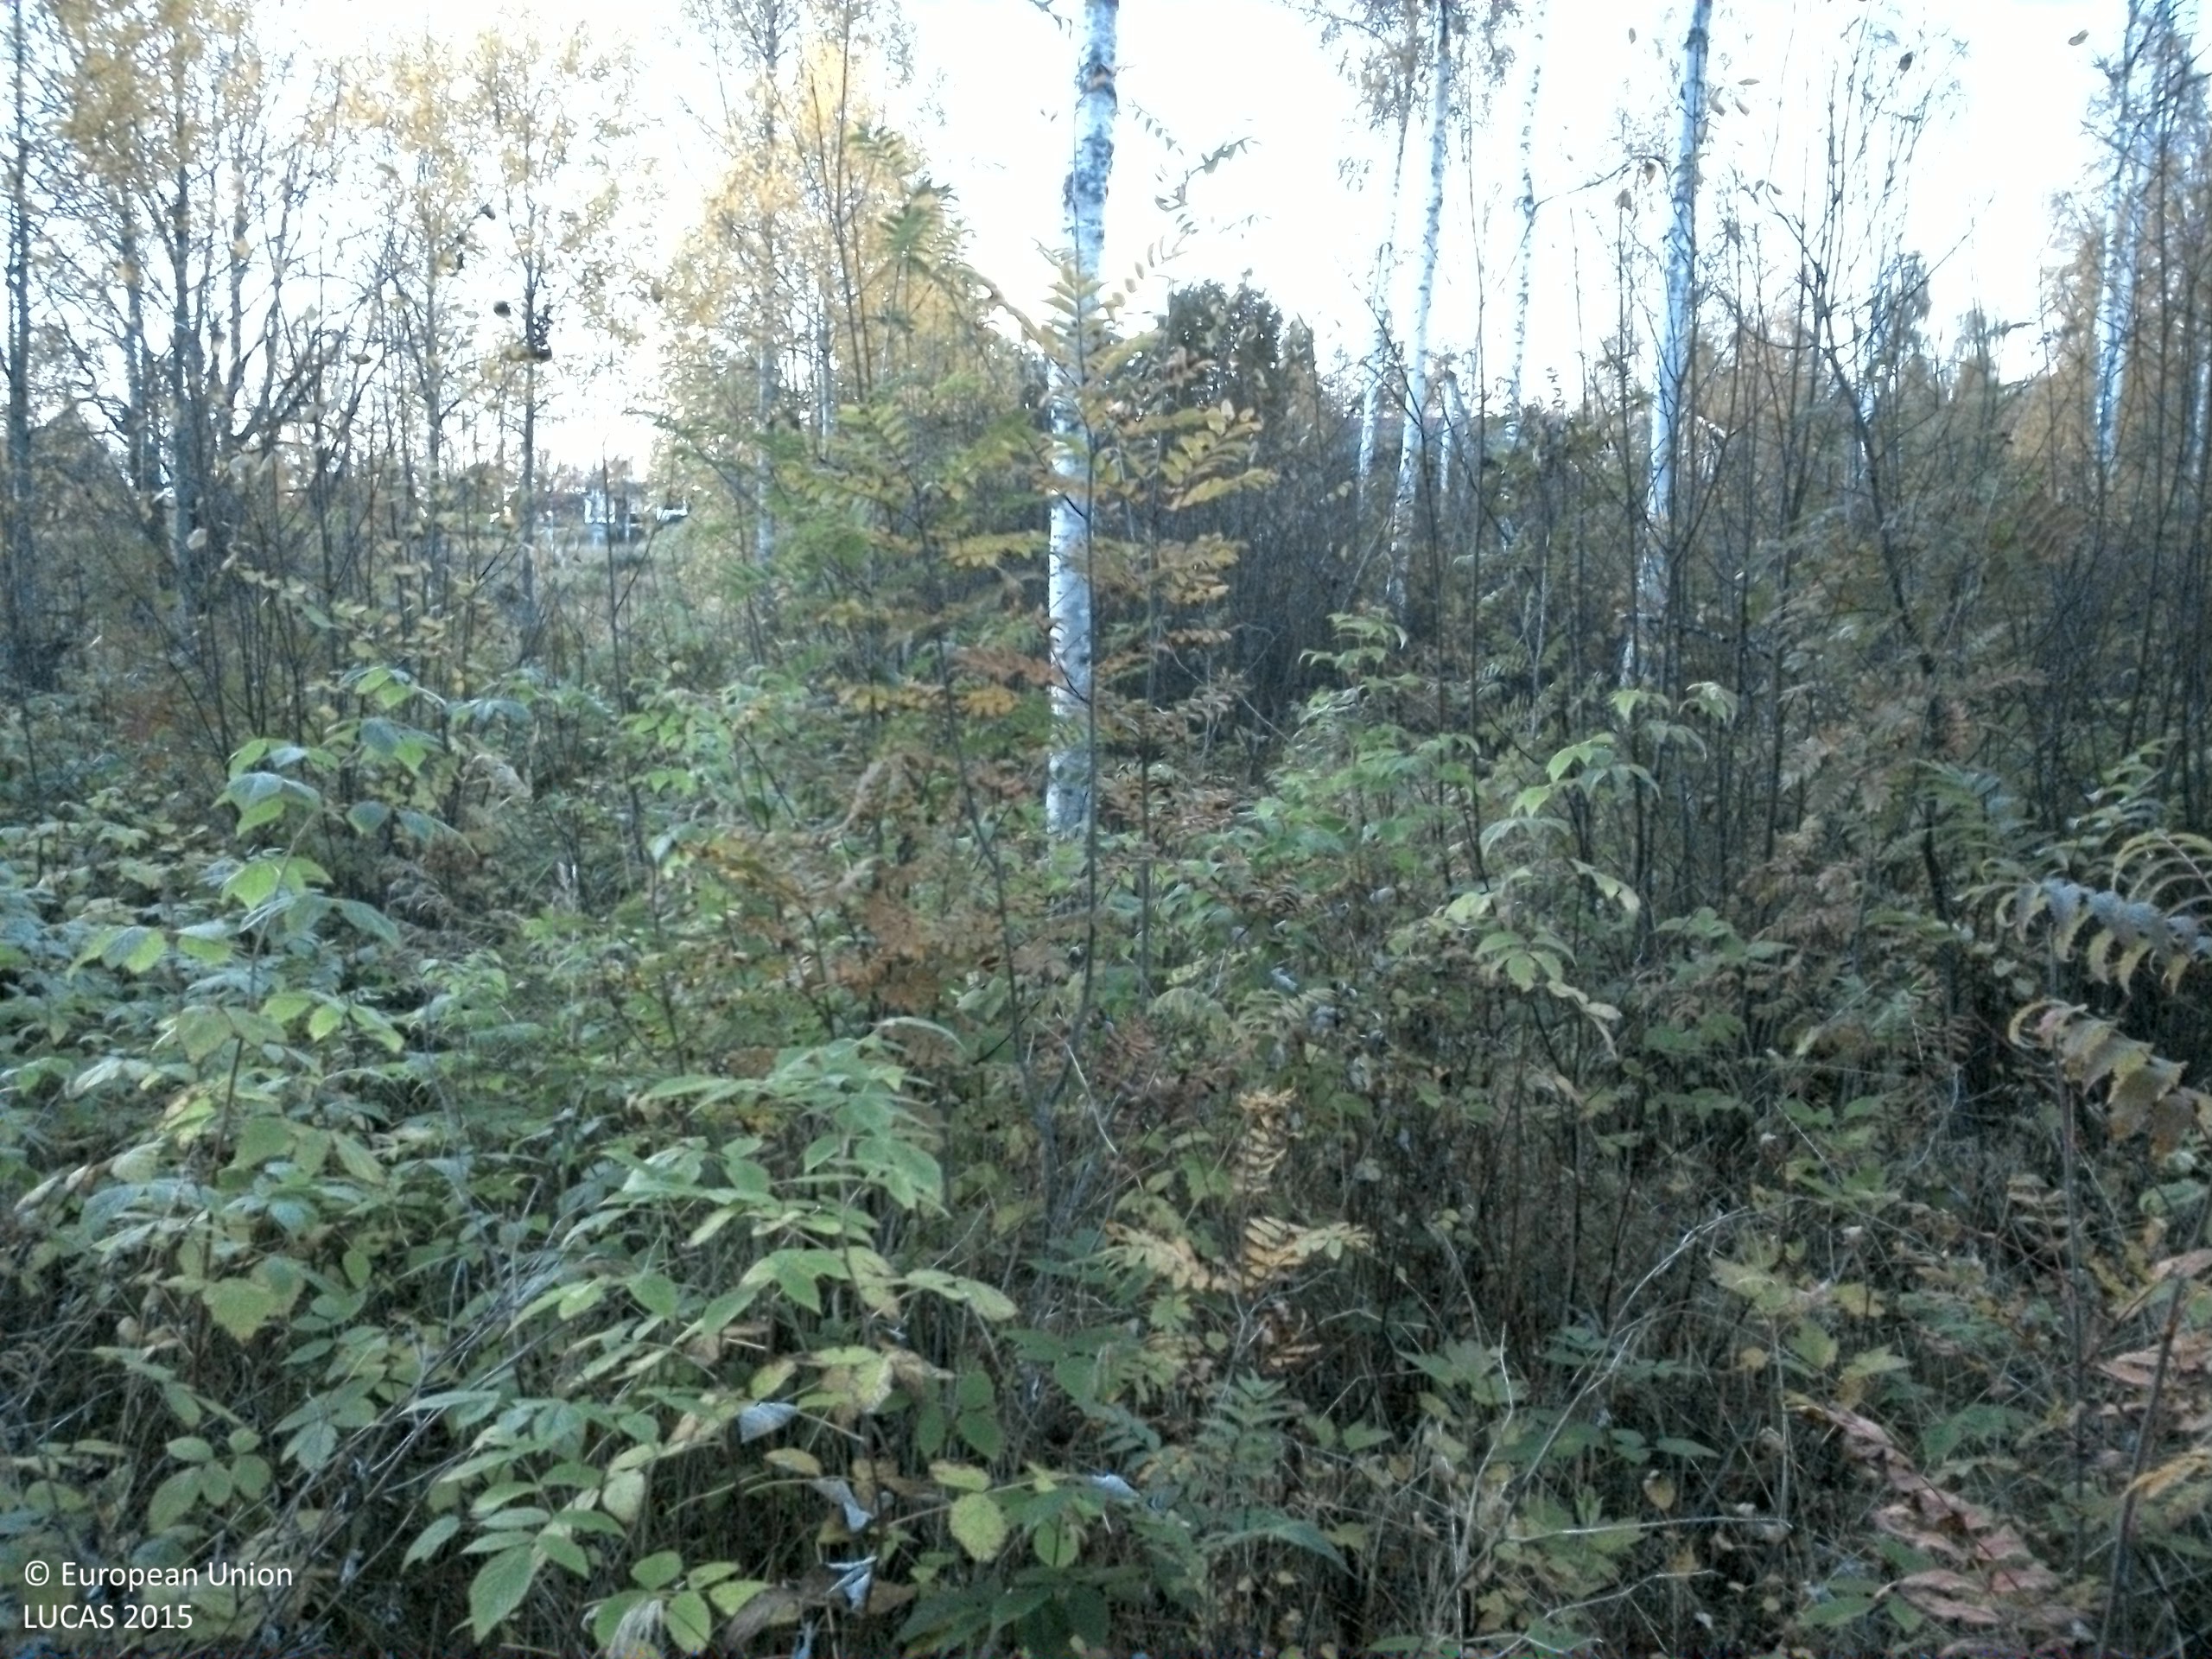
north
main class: Woodland
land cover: Broadleaved woodland
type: boreal forest
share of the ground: 10 - 25 %
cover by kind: shrubs 45 %, herbaceous plants 30 %, broadleaved forest trees 25 %
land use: Forestry
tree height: > 5 m
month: October
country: SE
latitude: 61.1894
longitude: 15.1008
